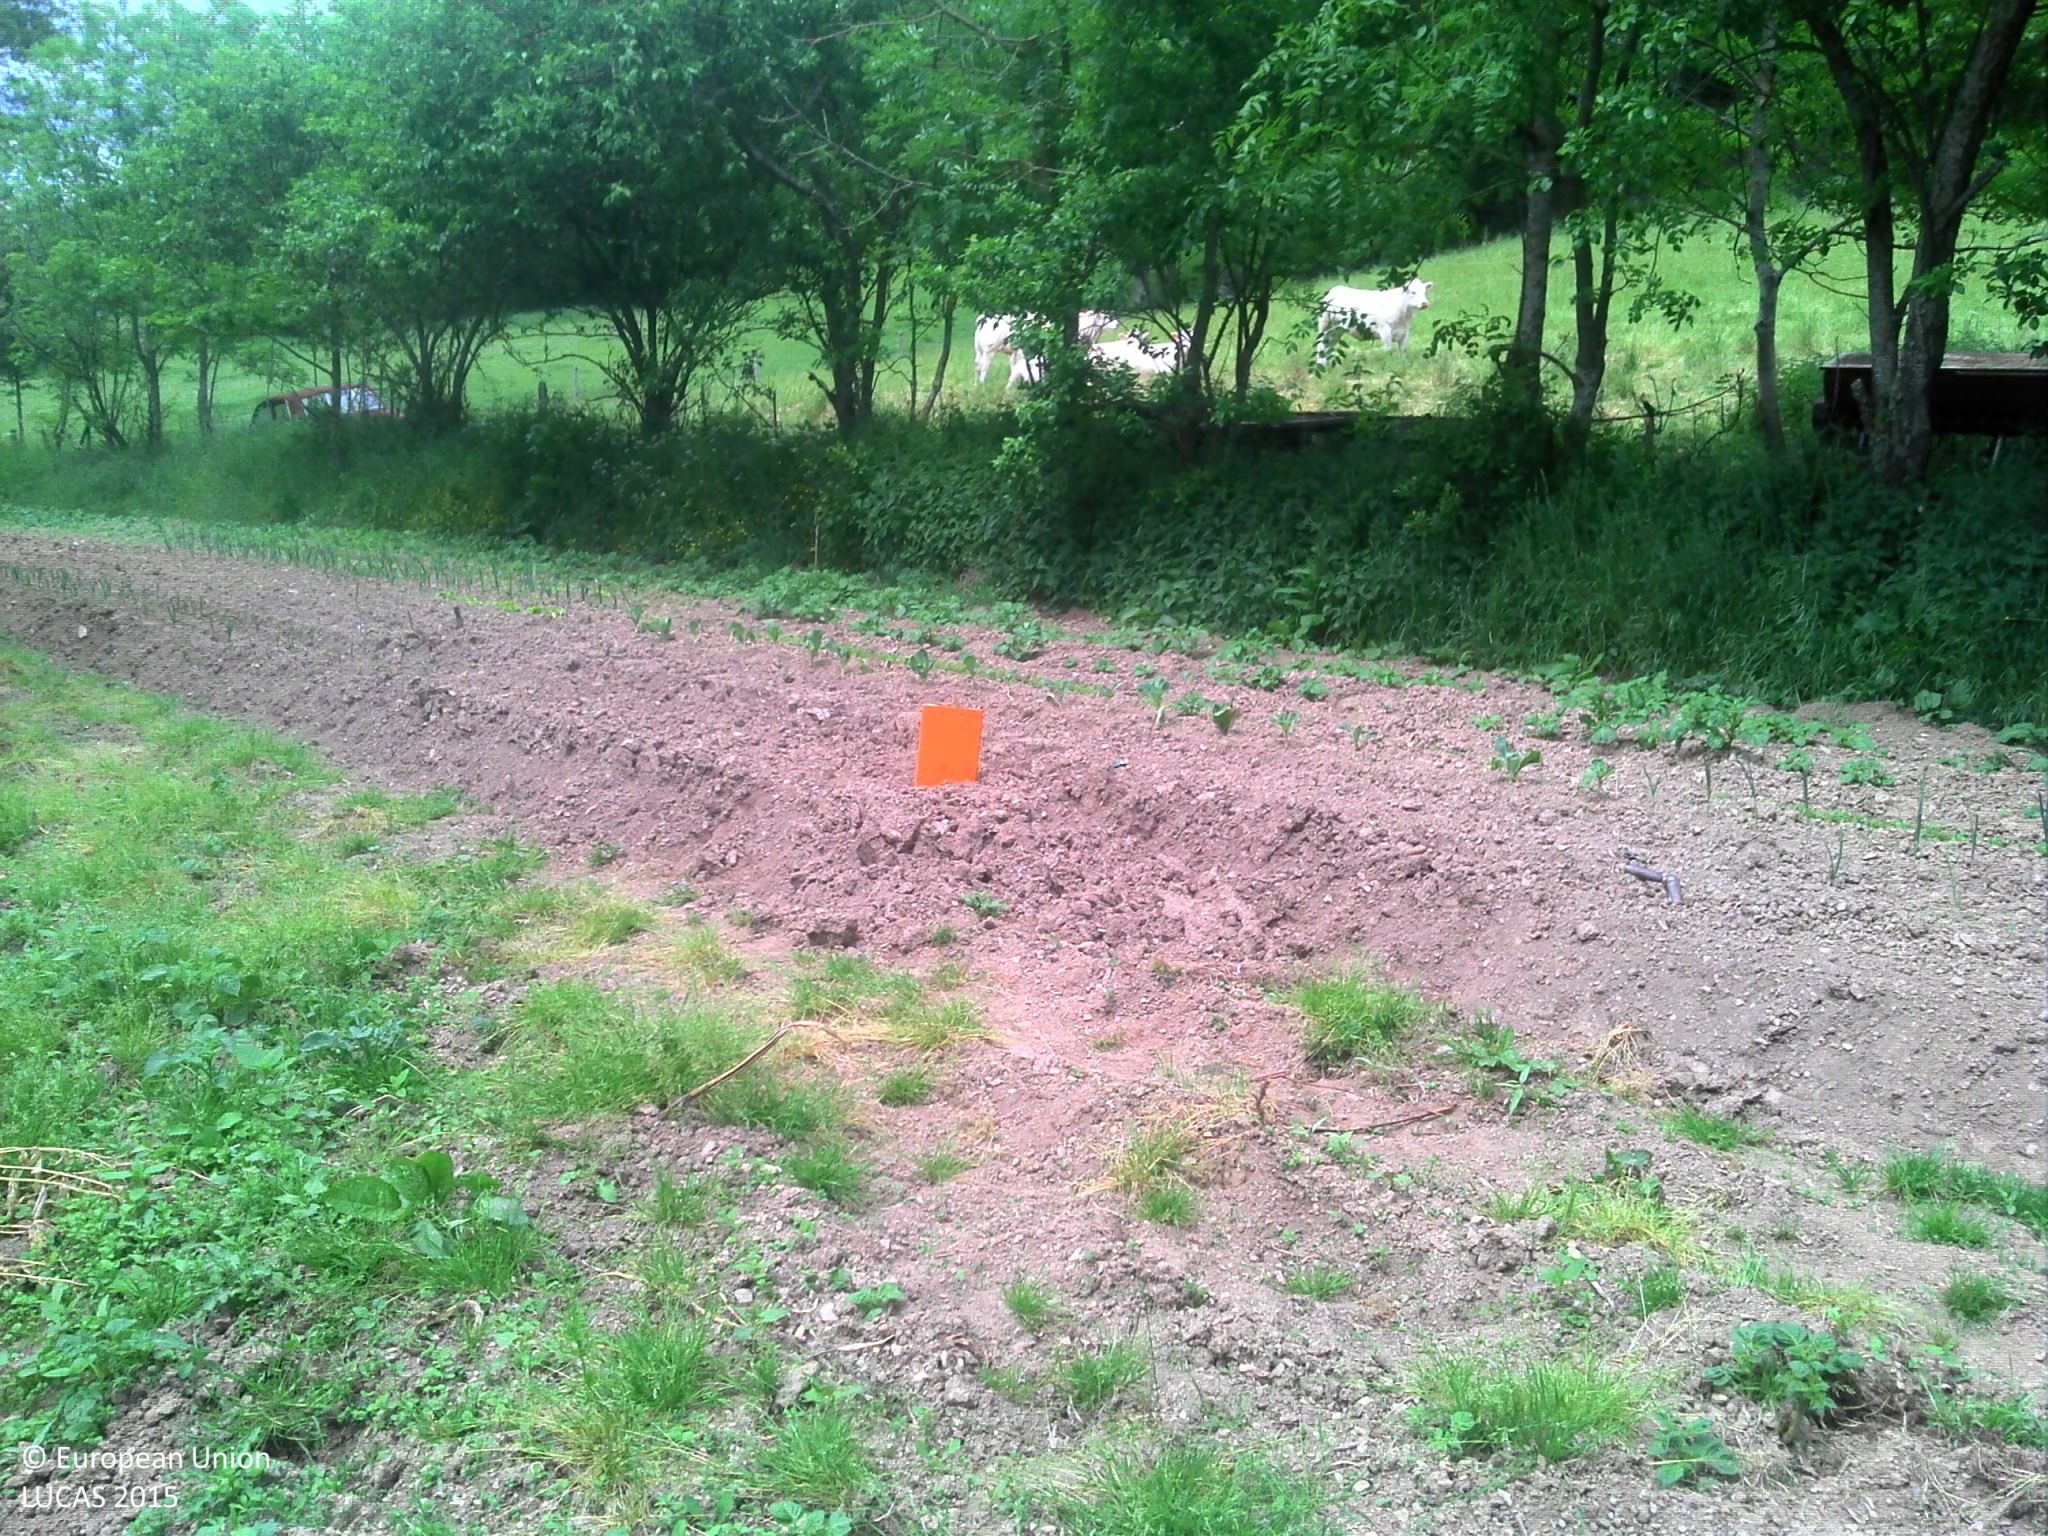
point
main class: Cropland
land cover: Other fresh vegetables
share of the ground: 10 - 25 %
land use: Kitchen garden
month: June
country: FR
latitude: 45.0490
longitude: 3.1844
